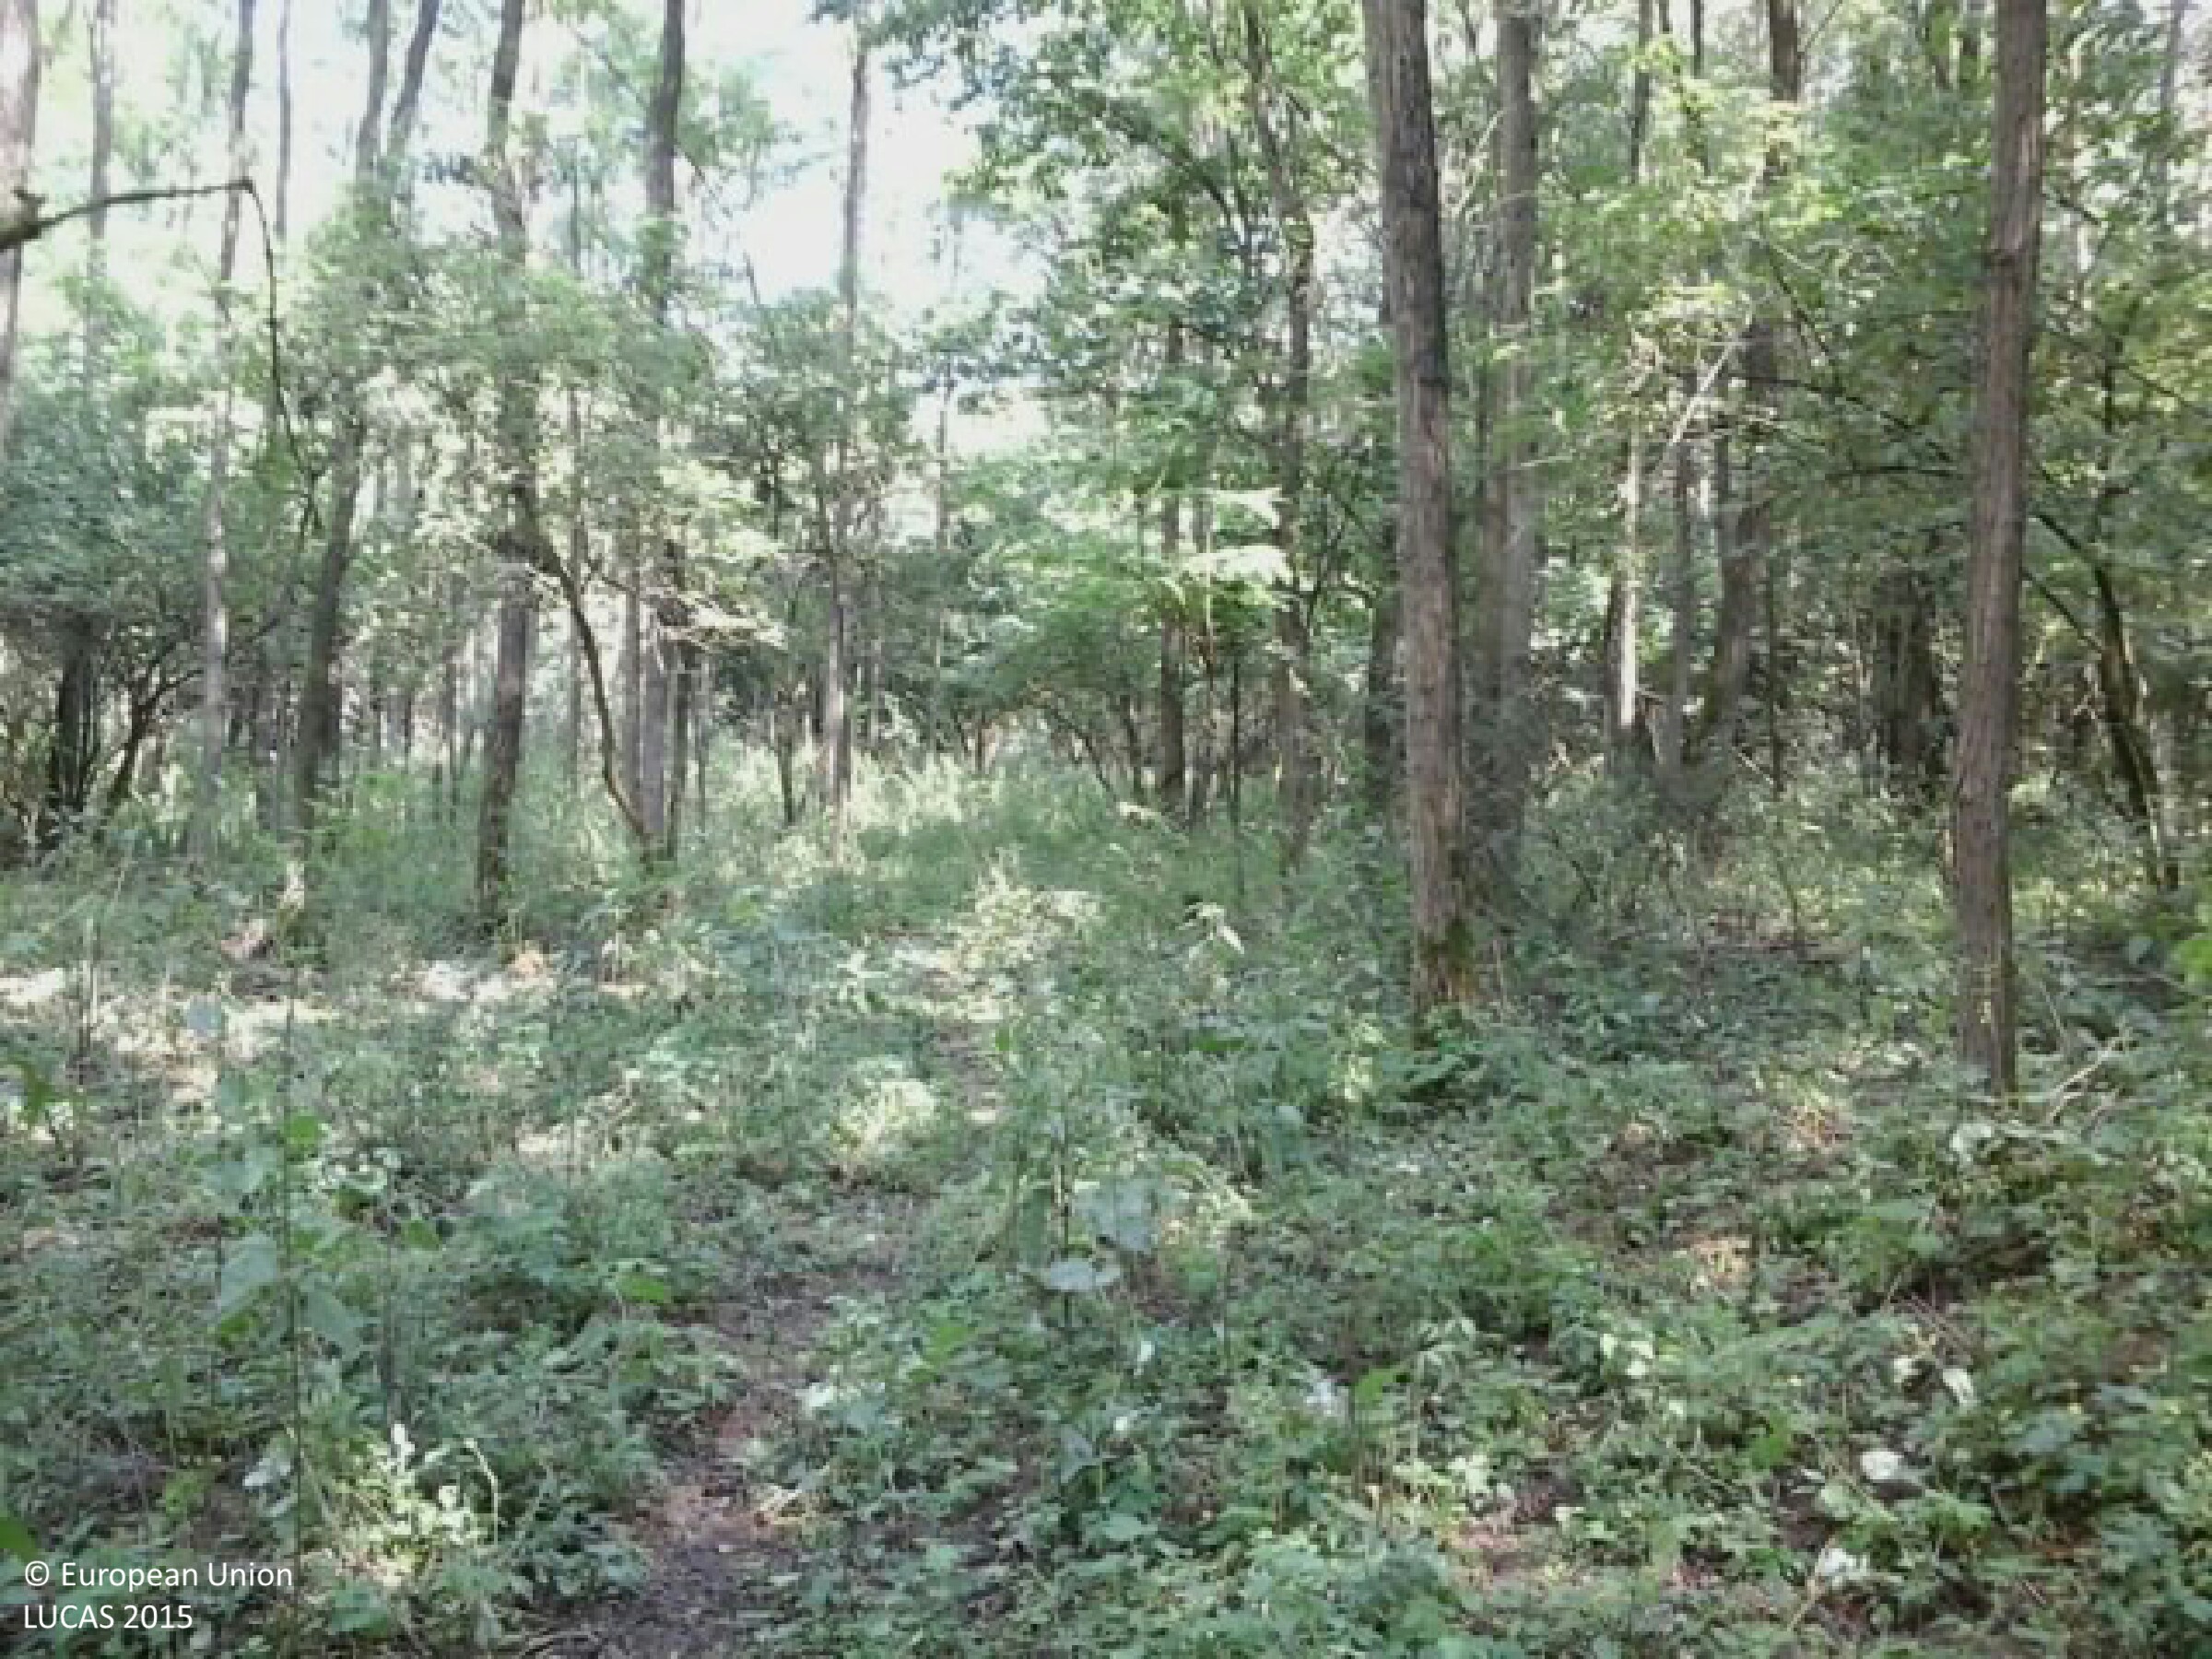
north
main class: Woodland
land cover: Broadleaved woodland
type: mesophytic deciduous forest
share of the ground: > 75 %
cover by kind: broadleaved forest trees 90 %, herbaceous plants 10 %
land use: Forestry
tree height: > 5 m
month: August
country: HU
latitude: 48.0046
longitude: 19.9869
